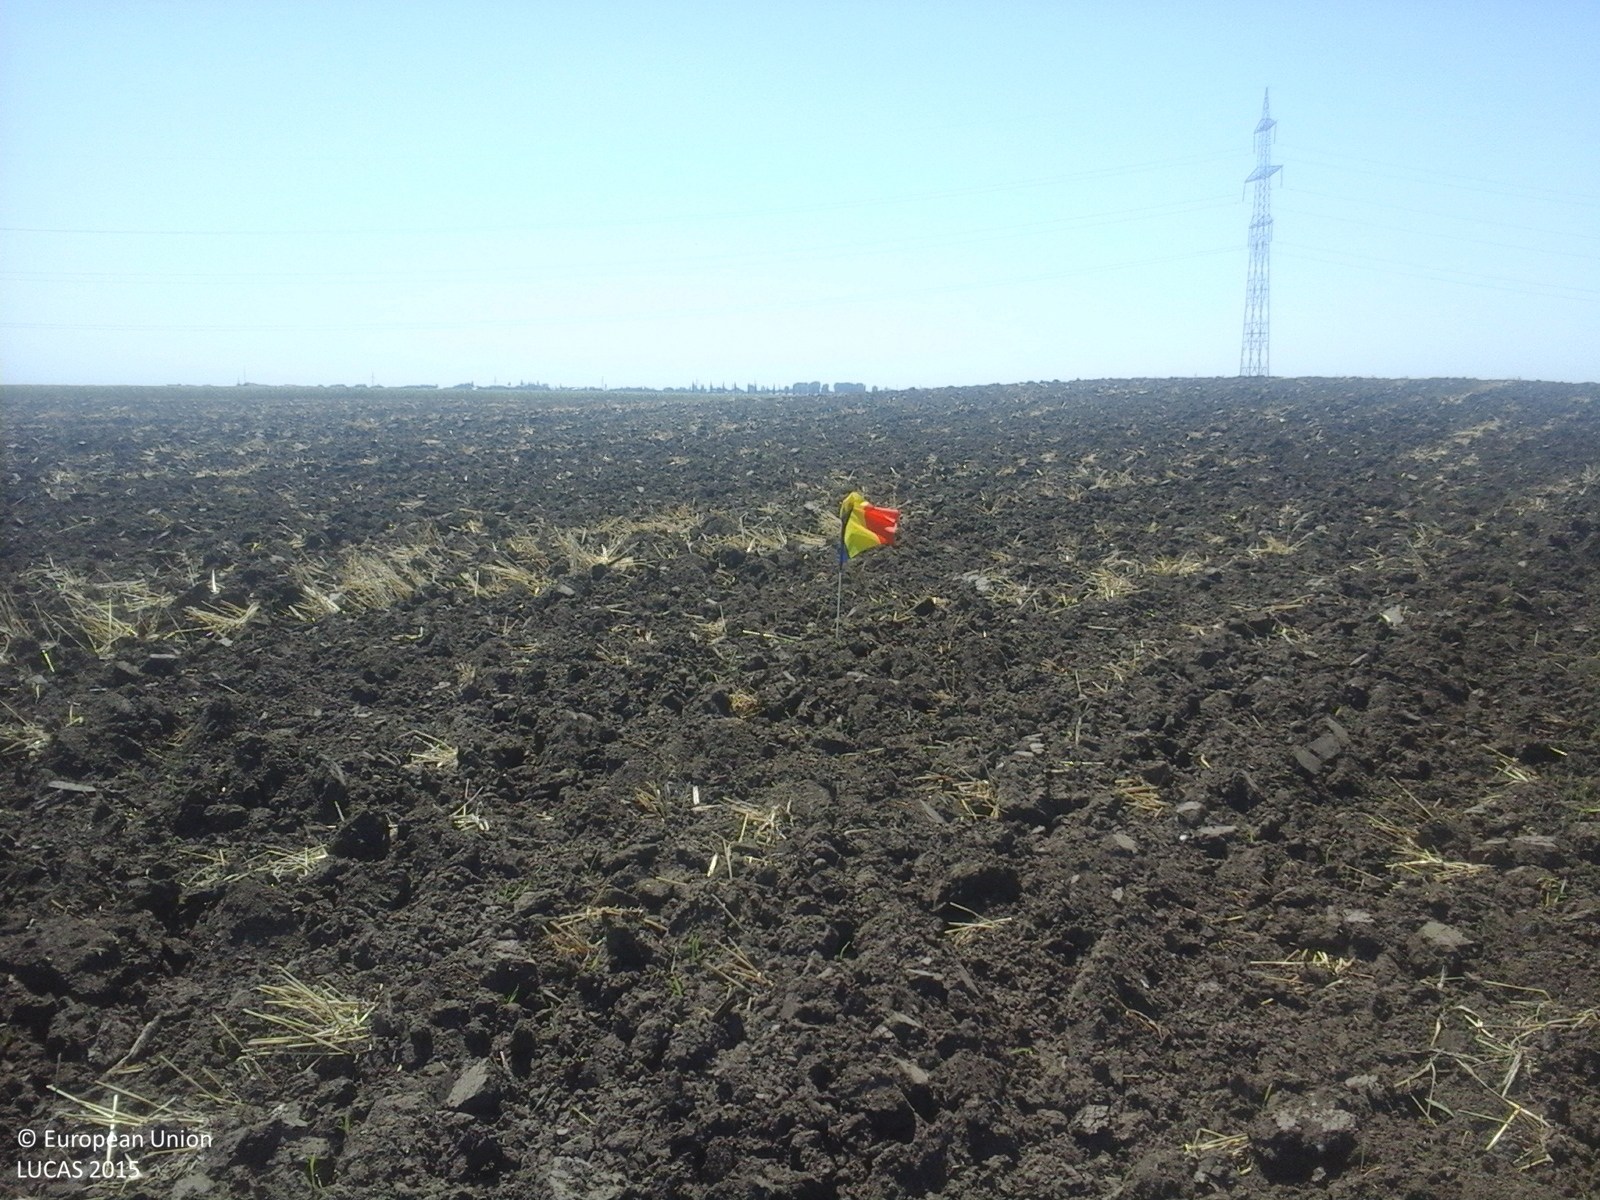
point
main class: Cropland
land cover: Durum wheat
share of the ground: < 10 %
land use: Agriculture (excluding fallow land and kitchen gardens)
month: July
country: RO
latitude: 44.4044
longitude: 26.6813
